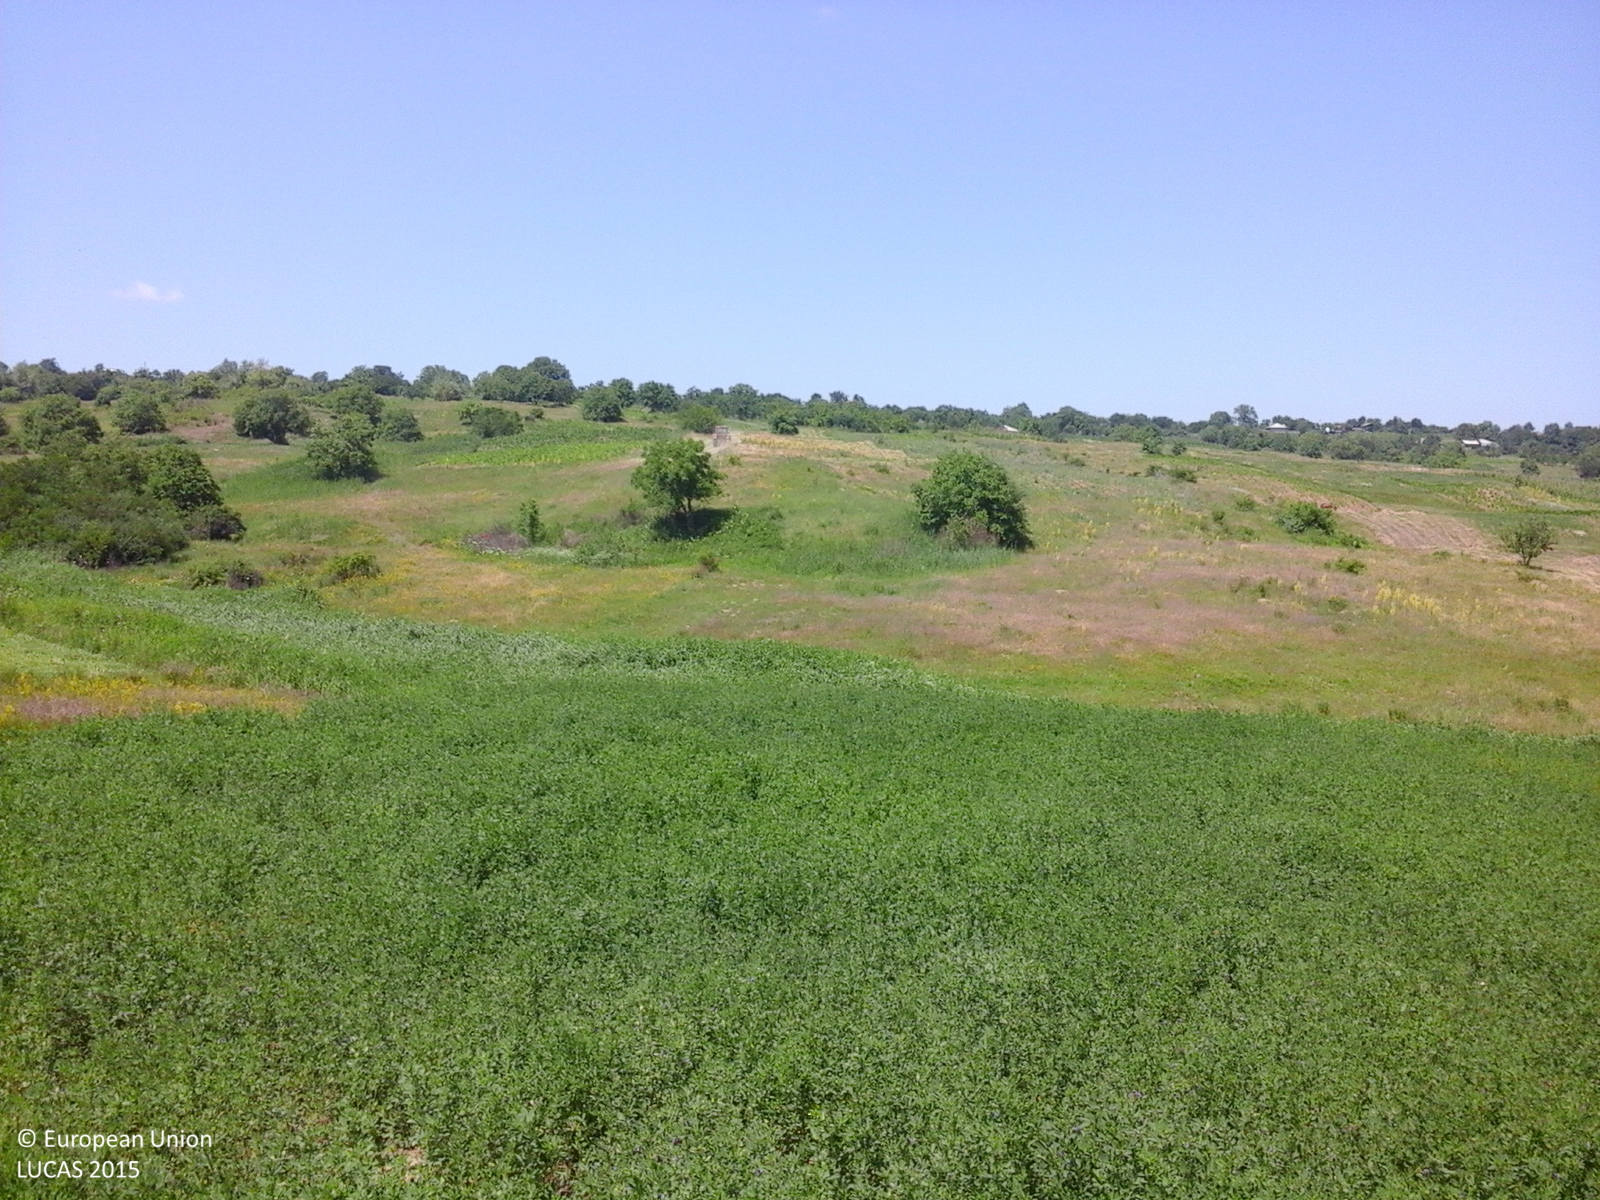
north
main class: Cropland
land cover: Lucerne
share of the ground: > 75 %
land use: Agriculture (excluding fallow land and kitchen gardens)
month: June
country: RO
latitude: 46.7946
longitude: 27.3630
